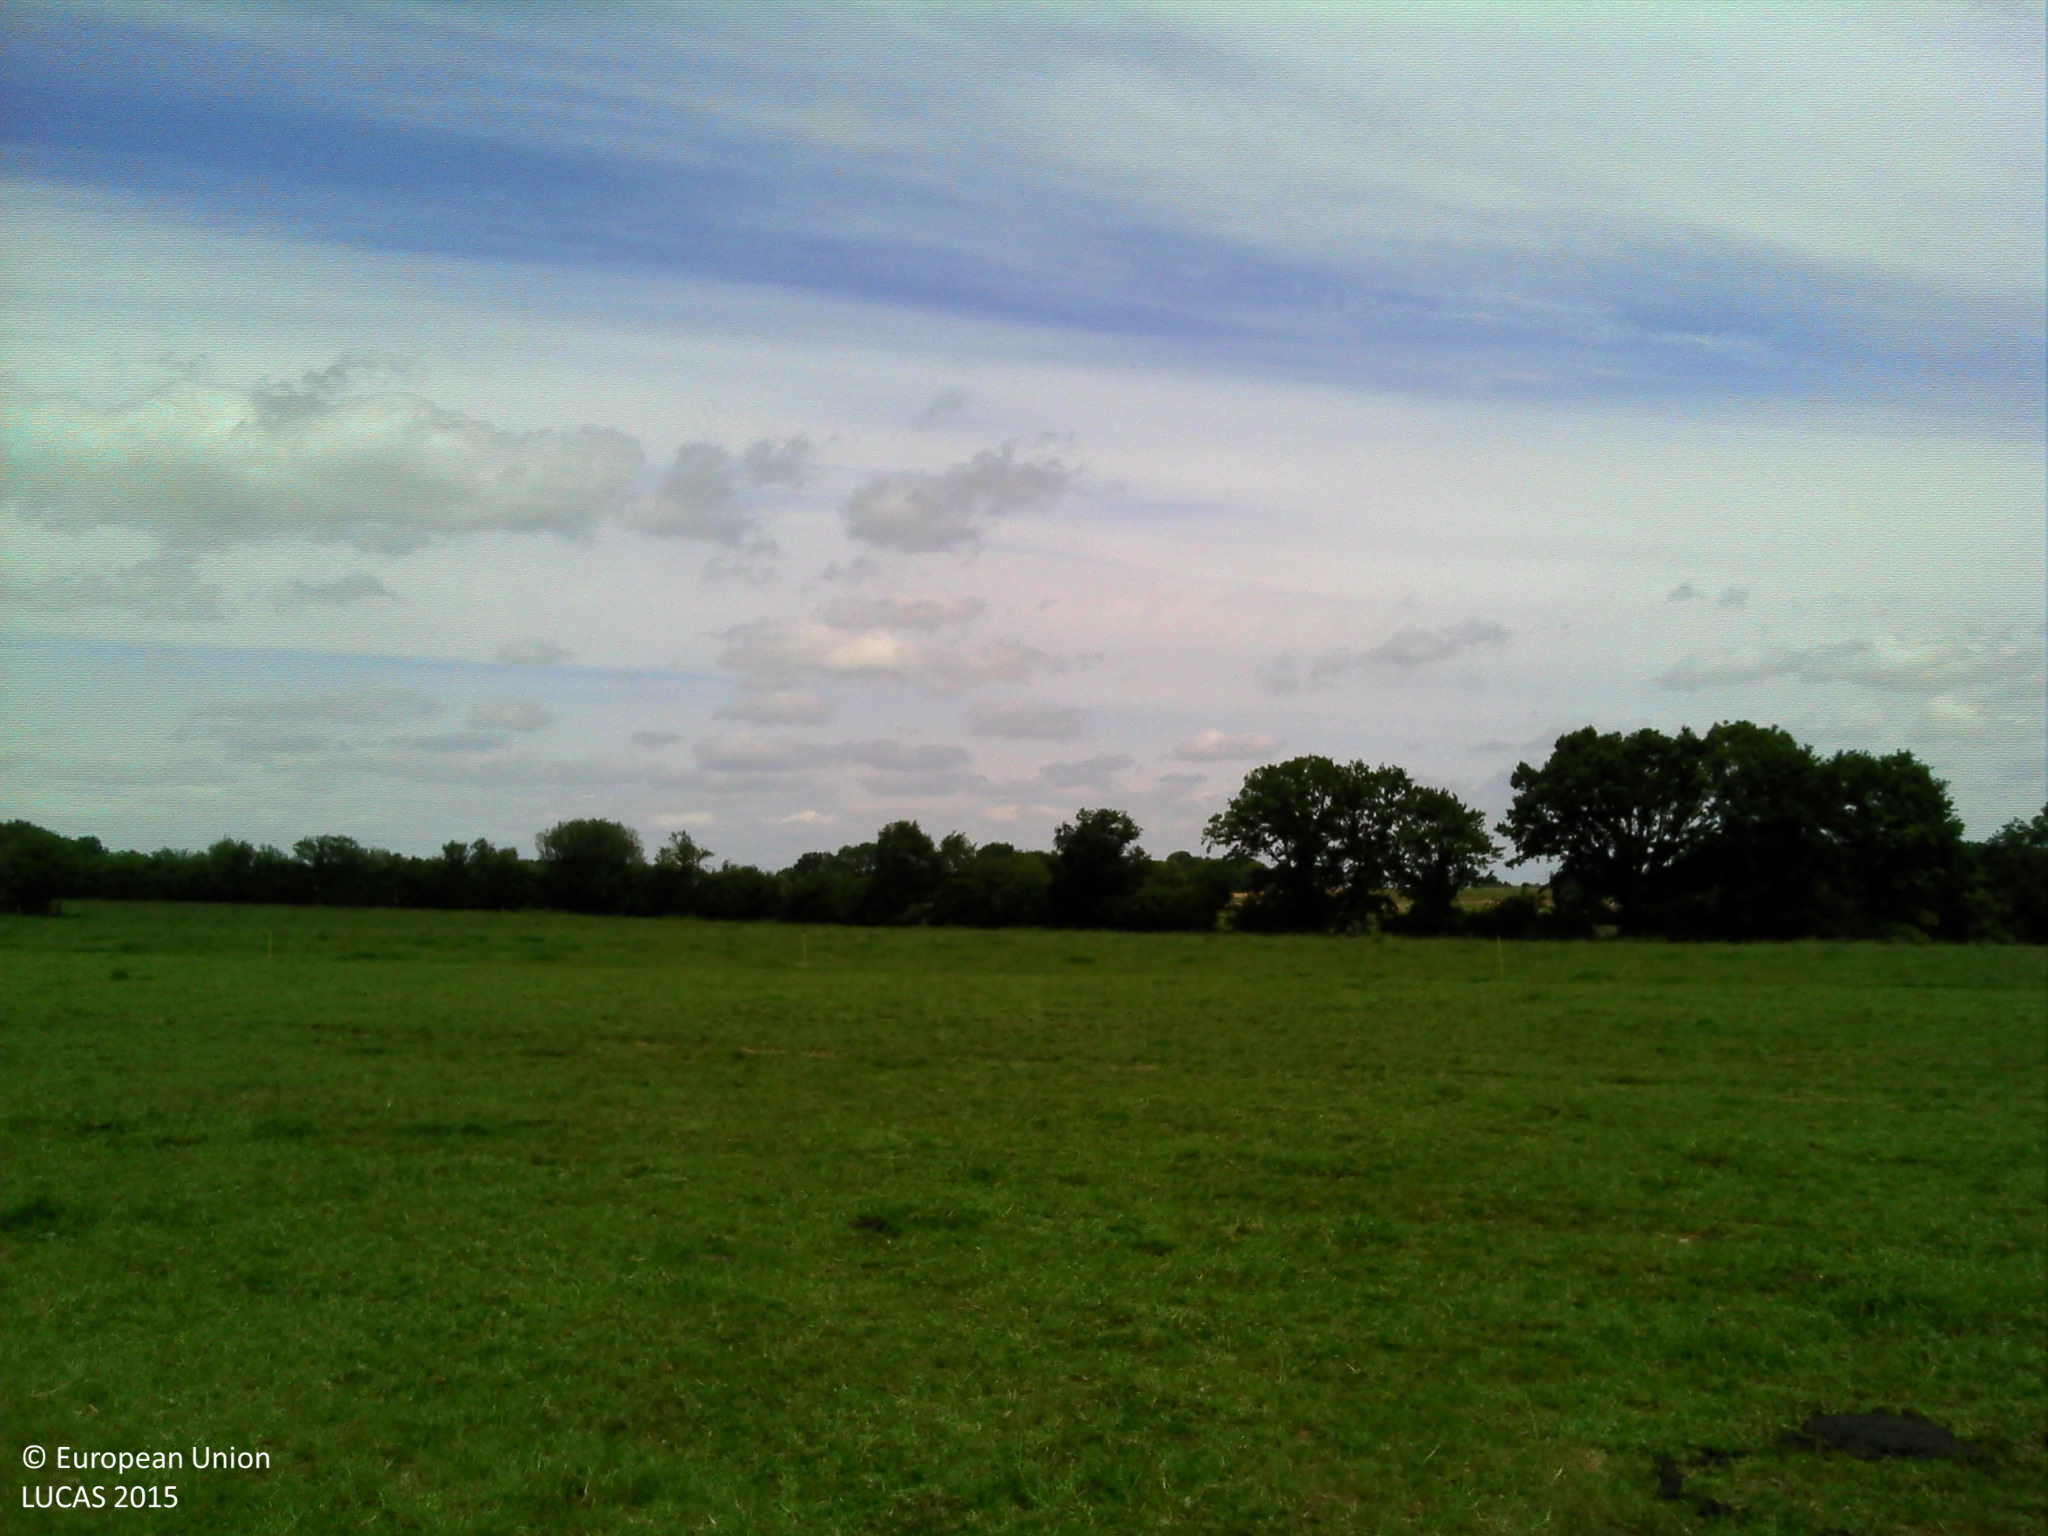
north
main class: Grassland
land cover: Grassland without tree/shrub cover
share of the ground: > 75 %
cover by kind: herbaceous plants 100 %
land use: Agriculture (excluding fallow land and kitchen gardens)
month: May
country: FR
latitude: 47.9868
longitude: 0.0167
